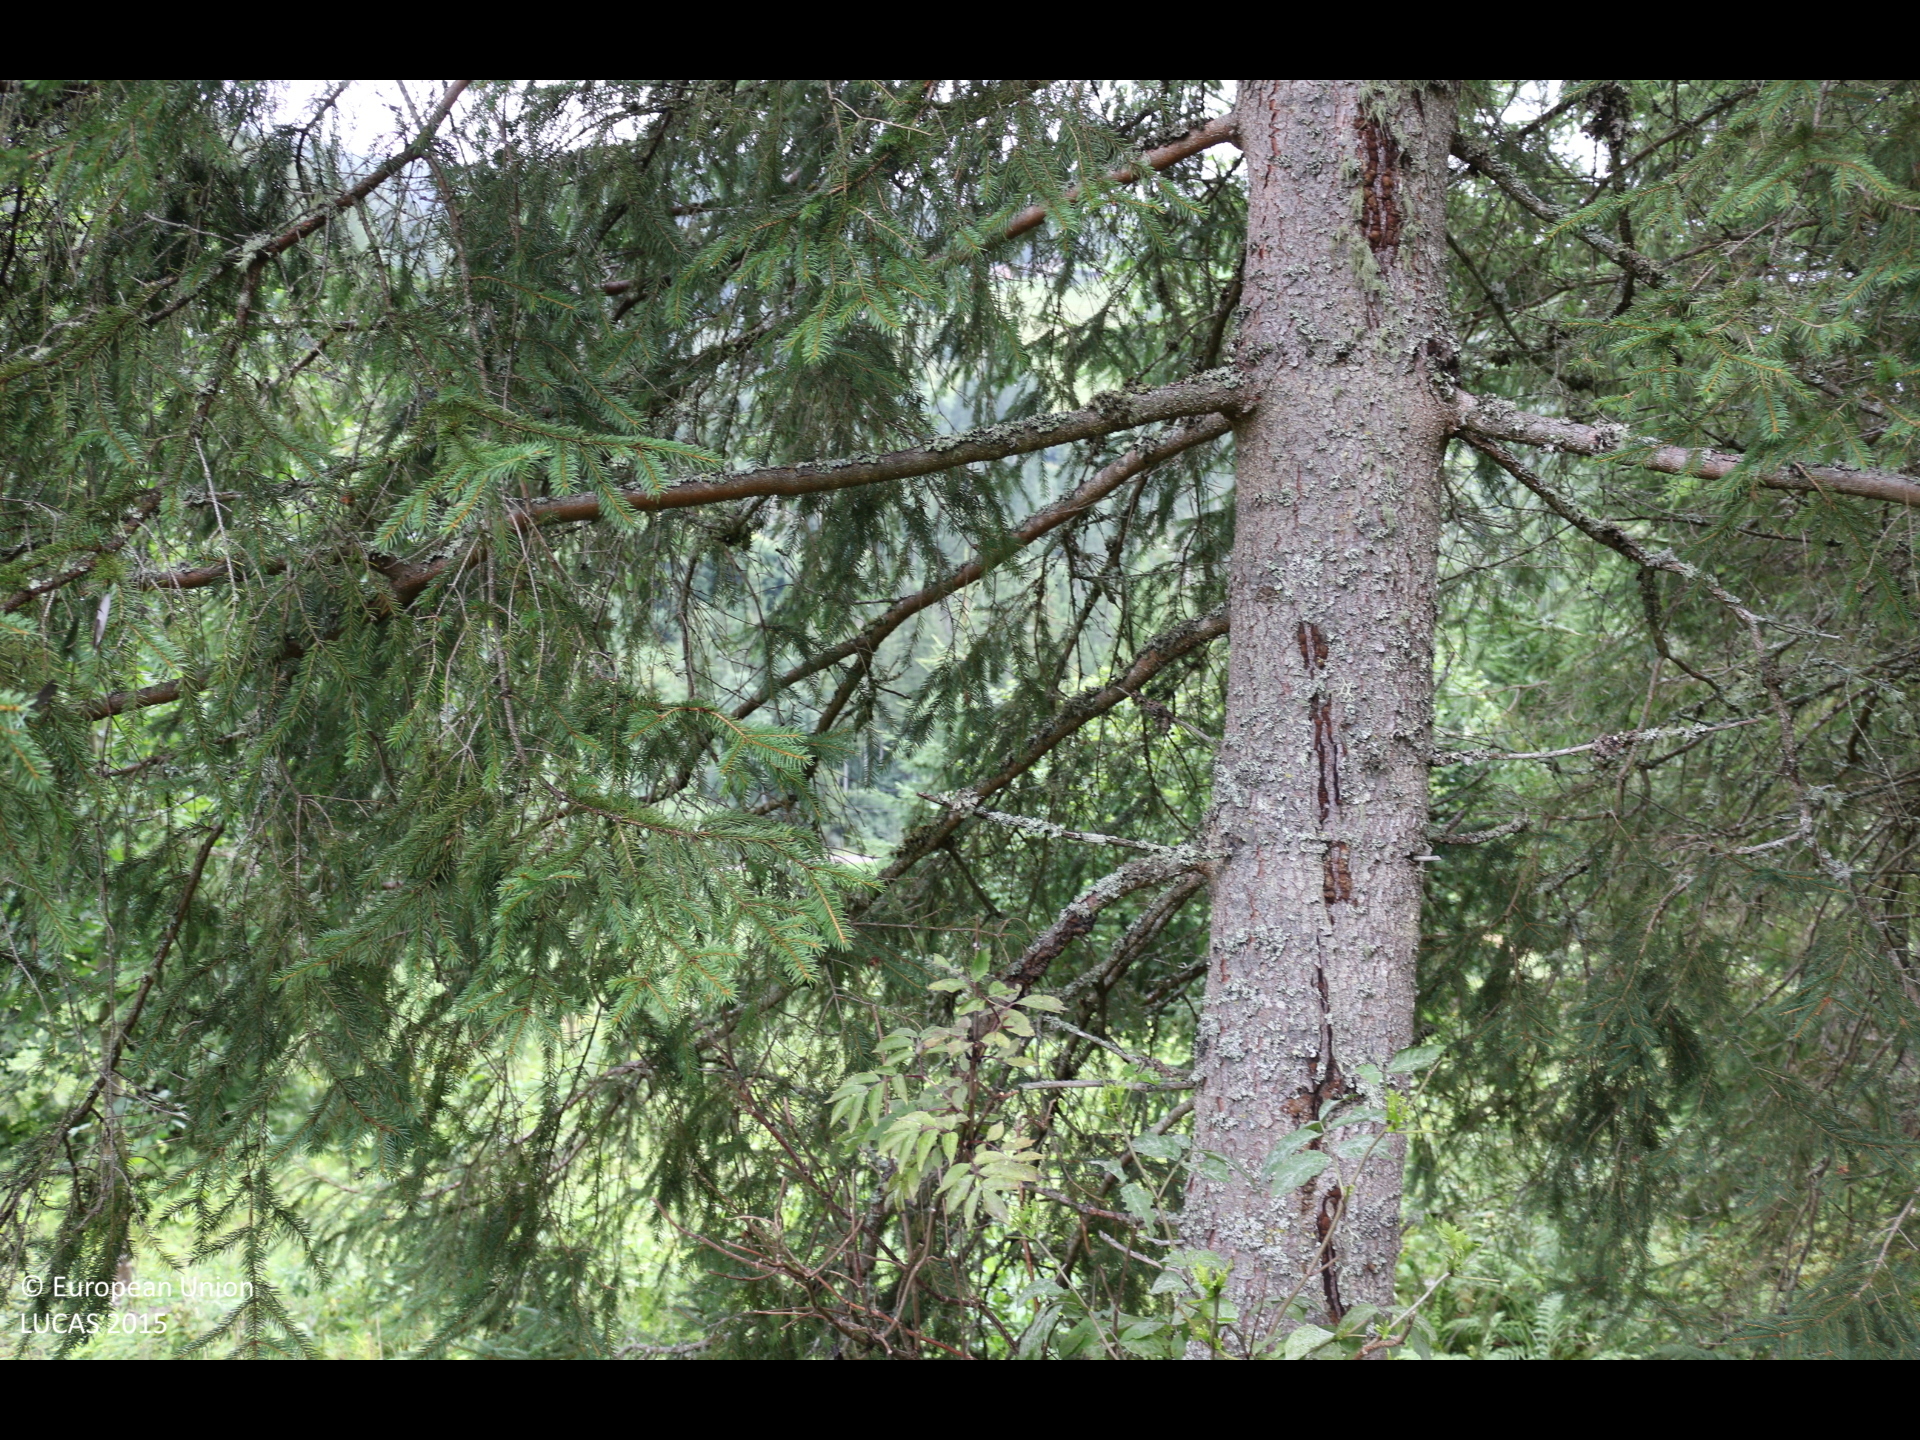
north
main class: Woodland
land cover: Spruce dominated coniferous woodland
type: alpine coniferous forest
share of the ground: > 75 %
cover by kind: coniferous forest trees 90 %, shrubs 5 %, herbaceous plants 5 %
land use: Forestry
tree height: > 5 m
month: July
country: AT
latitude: 46.9344
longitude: 14.2406
